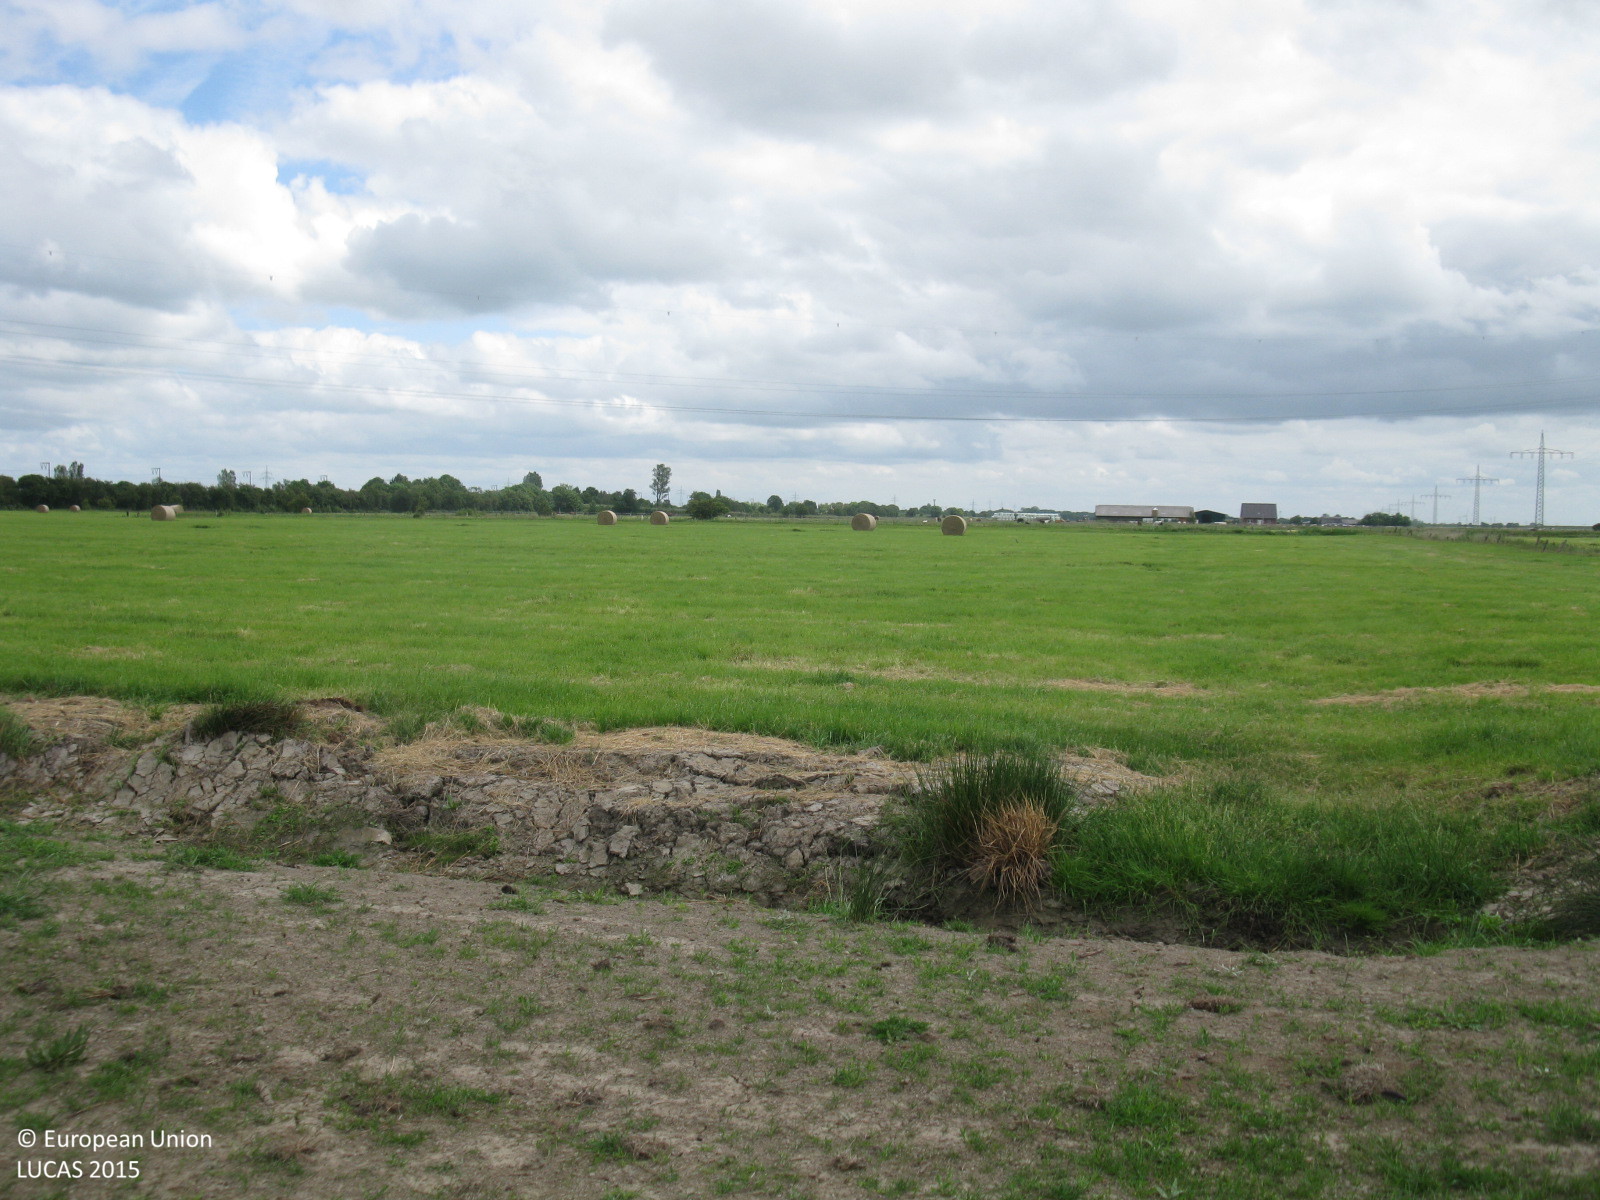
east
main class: Grassland
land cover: Grassland without tree/shrub cover
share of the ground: > 75 %
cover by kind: herbaceous plants 100 %
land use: Agriculture (excluding fallow land and kitchen gardens)
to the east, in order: Grassland without tree/shrub cover; Fences; Grass margins; Inland fresh running water; Grassland without tree/shrub cover; Ditches and canals; Grassland without tree/shrub cover
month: June
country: DE
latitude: 53.3355
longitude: 7.2824
